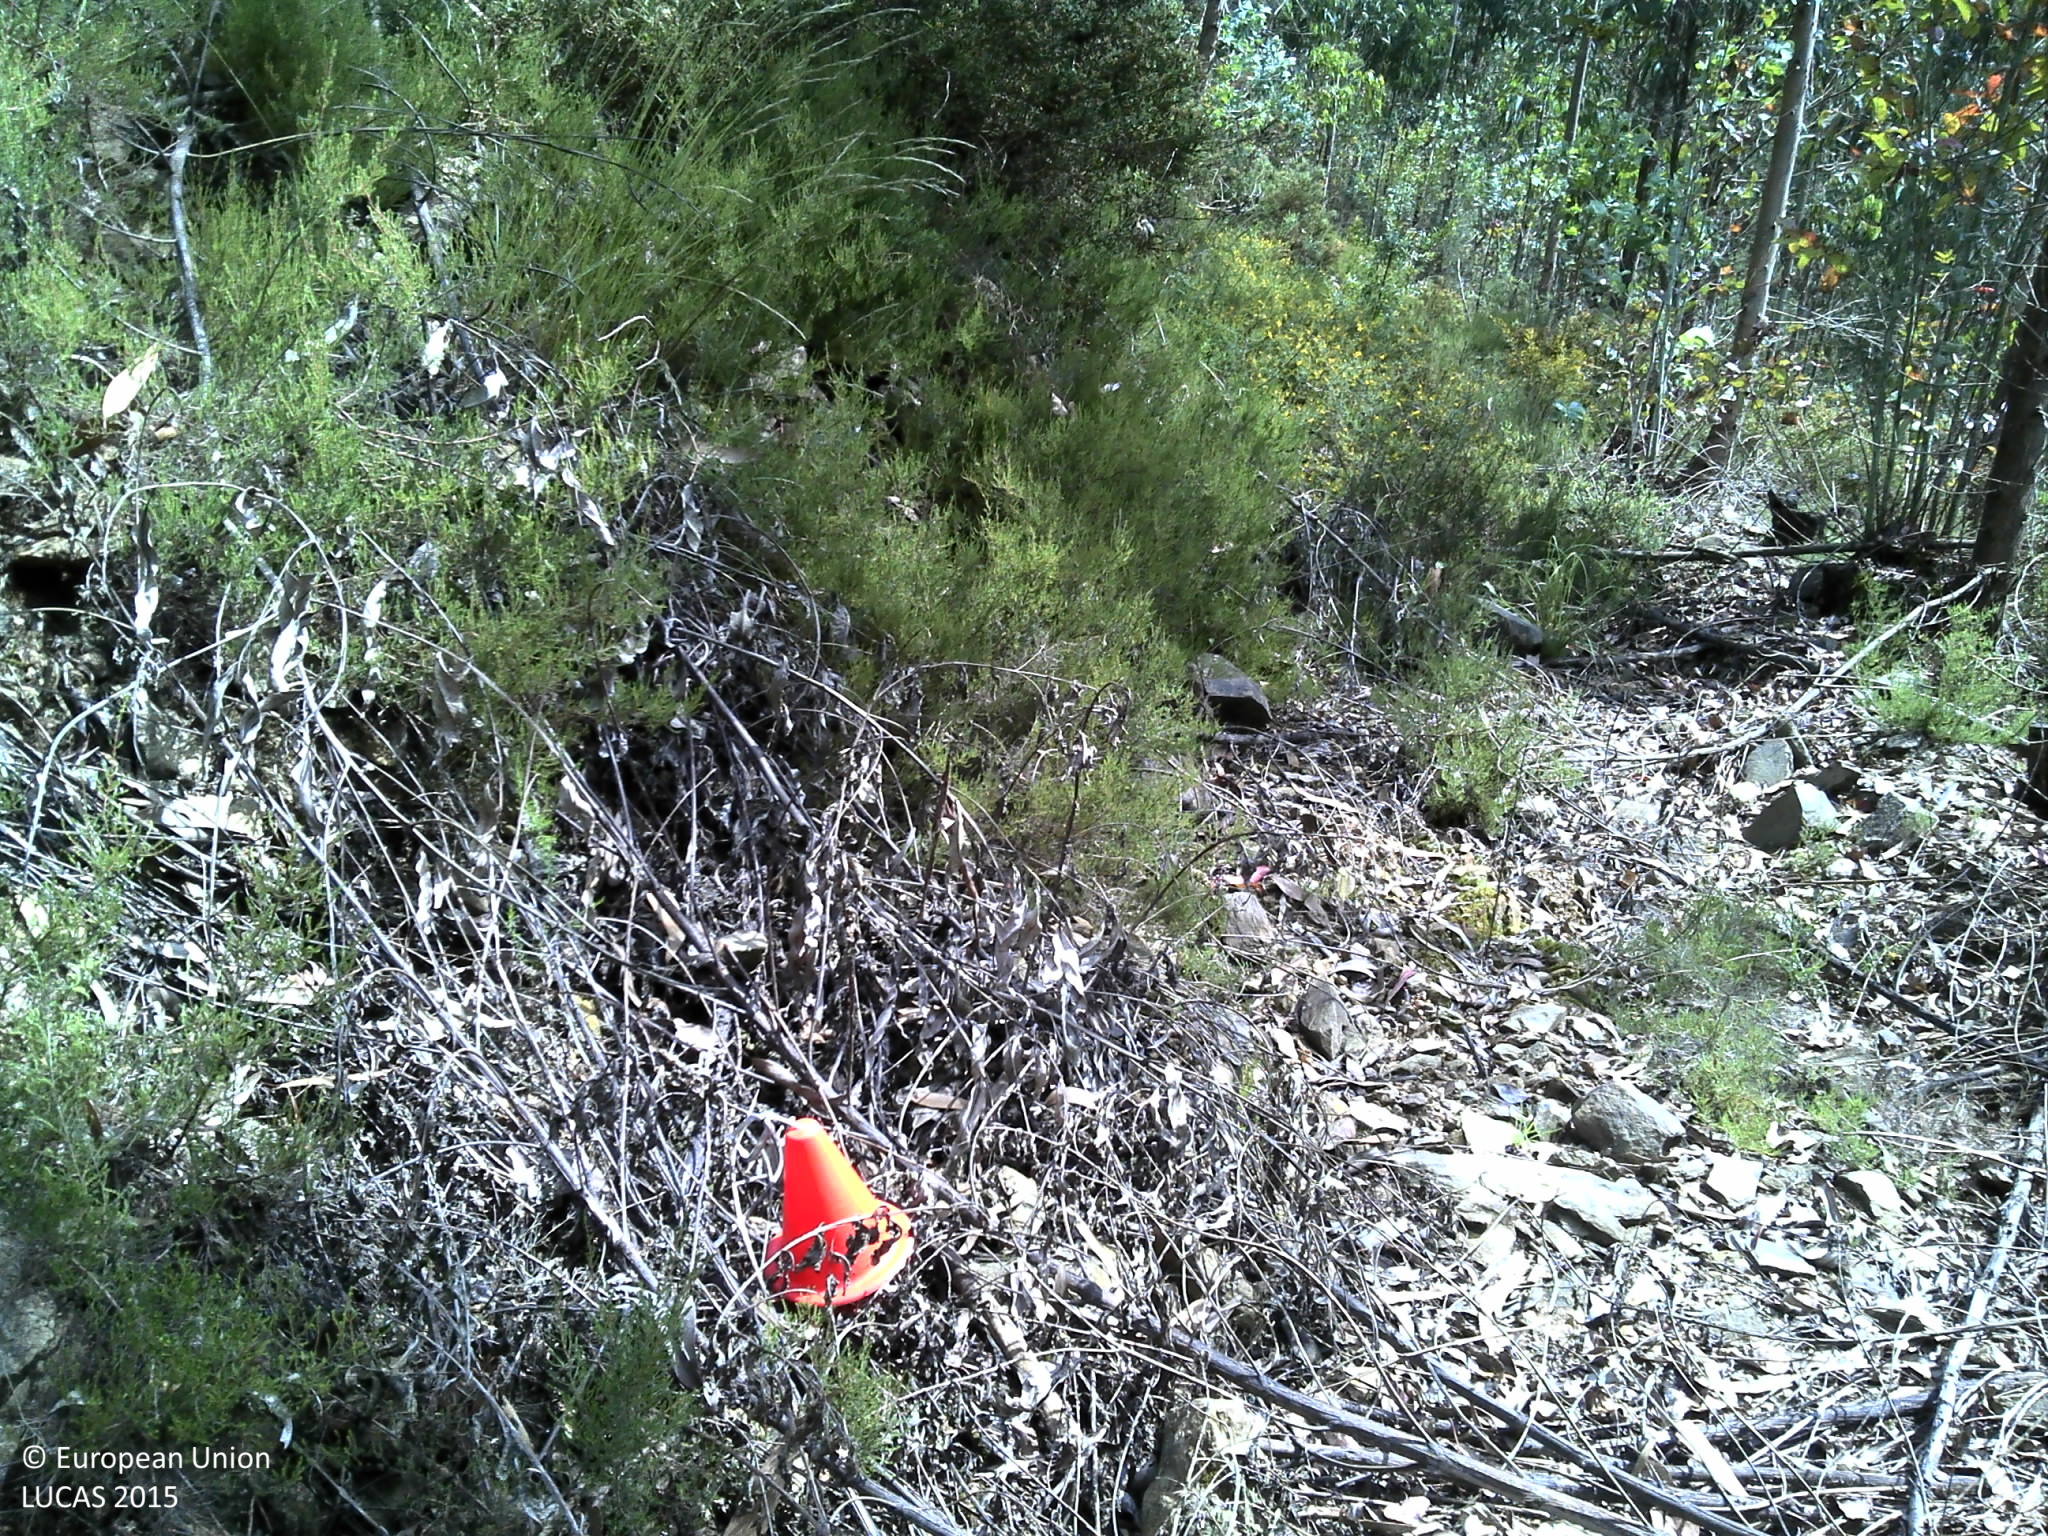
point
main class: Woodland
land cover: Broadleaved woodland
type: exotic forest
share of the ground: 50 - 75 %
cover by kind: broadleaved forest trees 70 %, shrubs 25 %, unconsolidated bare surface 5 %
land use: Forestry
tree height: > 5 m
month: May
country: PT
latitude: 41.2565
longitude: -8.4457
